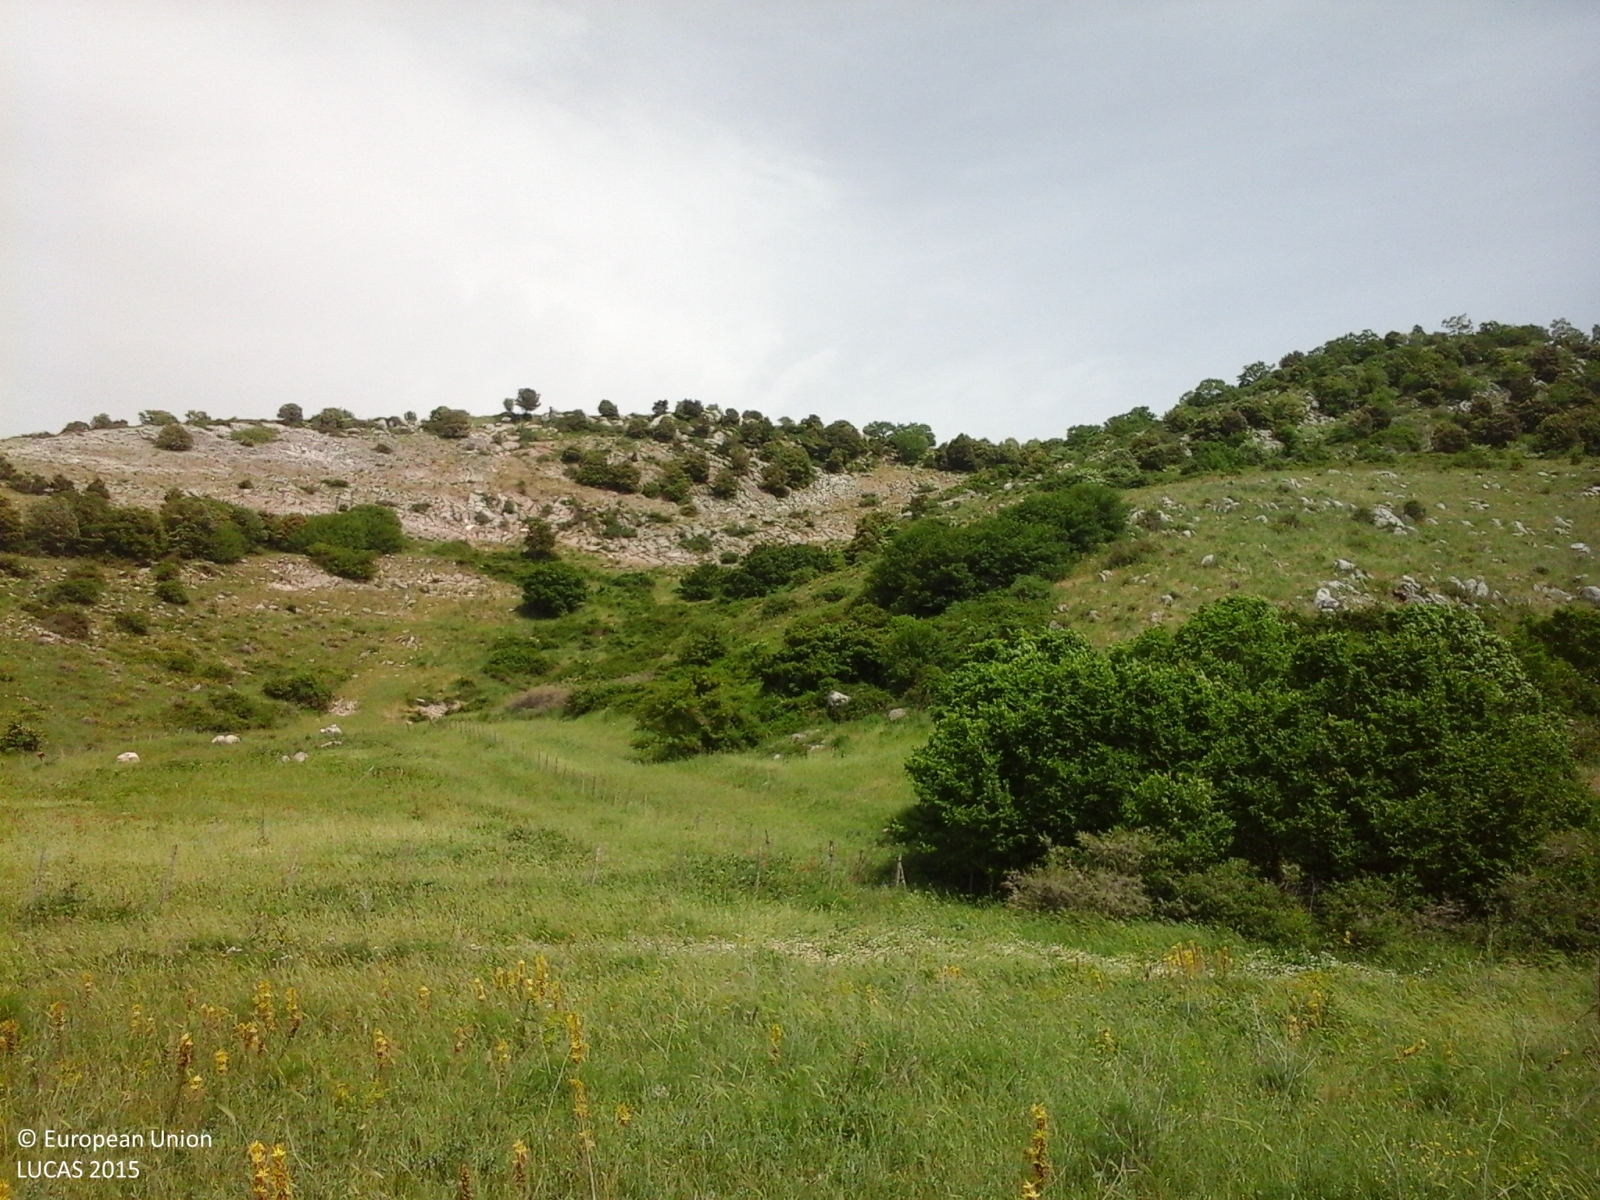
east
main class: Grassland
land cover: Spontaneously vegetated surfaces
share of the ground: > 75 %
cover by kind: herbaceous plants 100 %
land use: Agriculture (excluding fallow land and kitchen gardens)
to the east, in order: Spontaneously vegetated surfaces; Fences; Spontaneously vegetated surfaces; Shrubland without tree cover; Tracks; Grassland without tree/shrub cover; Fences; Spontaneously vegetated surfaces; Fences; Grassland without tree/shrub cover; Grassland with sparse tree/shrub cover; Broadleaved woodland
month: May
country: IT
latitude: 37.6650
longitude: 13.4997
